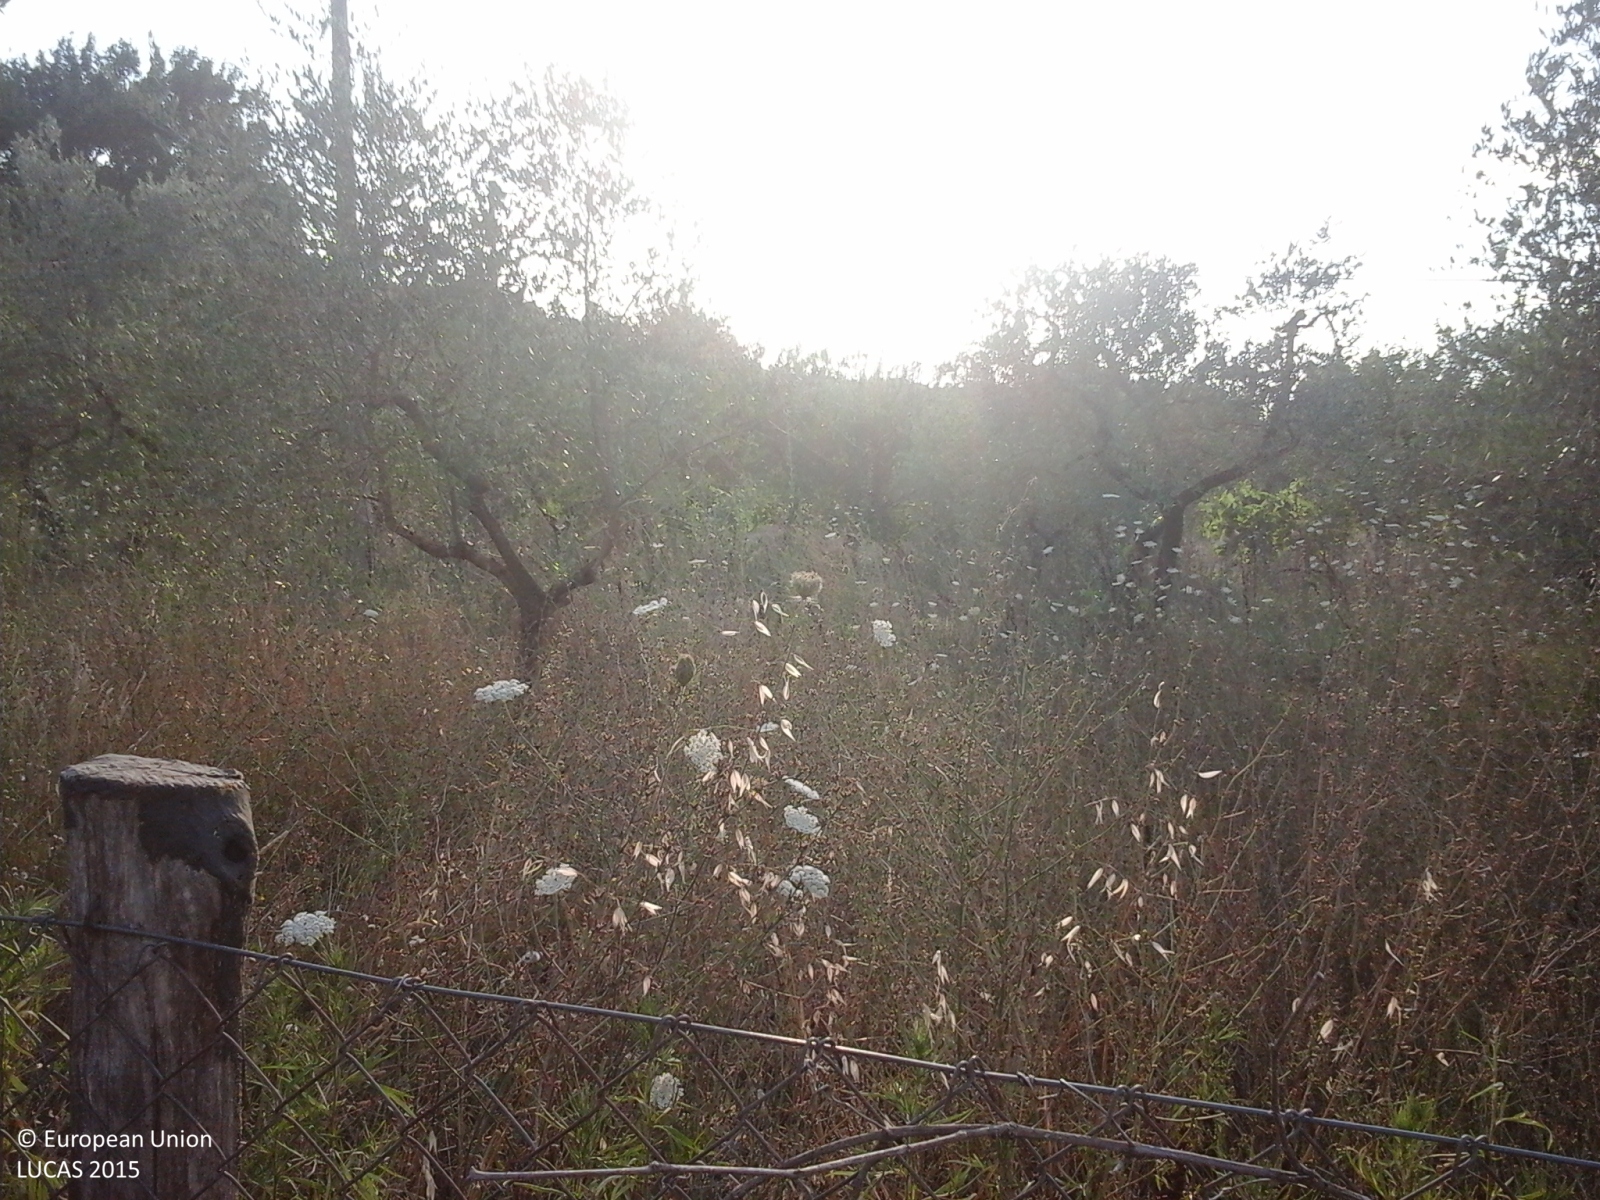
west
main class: Cropland
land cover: Olive groves
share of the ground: > 75 %
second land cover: Spontaneously vegetated surfaces
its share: > 75 %
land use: Agriculture (excluding fallow land and kitchen gardens)
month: July
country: IT
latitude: 43.6967
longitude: 10.9528
